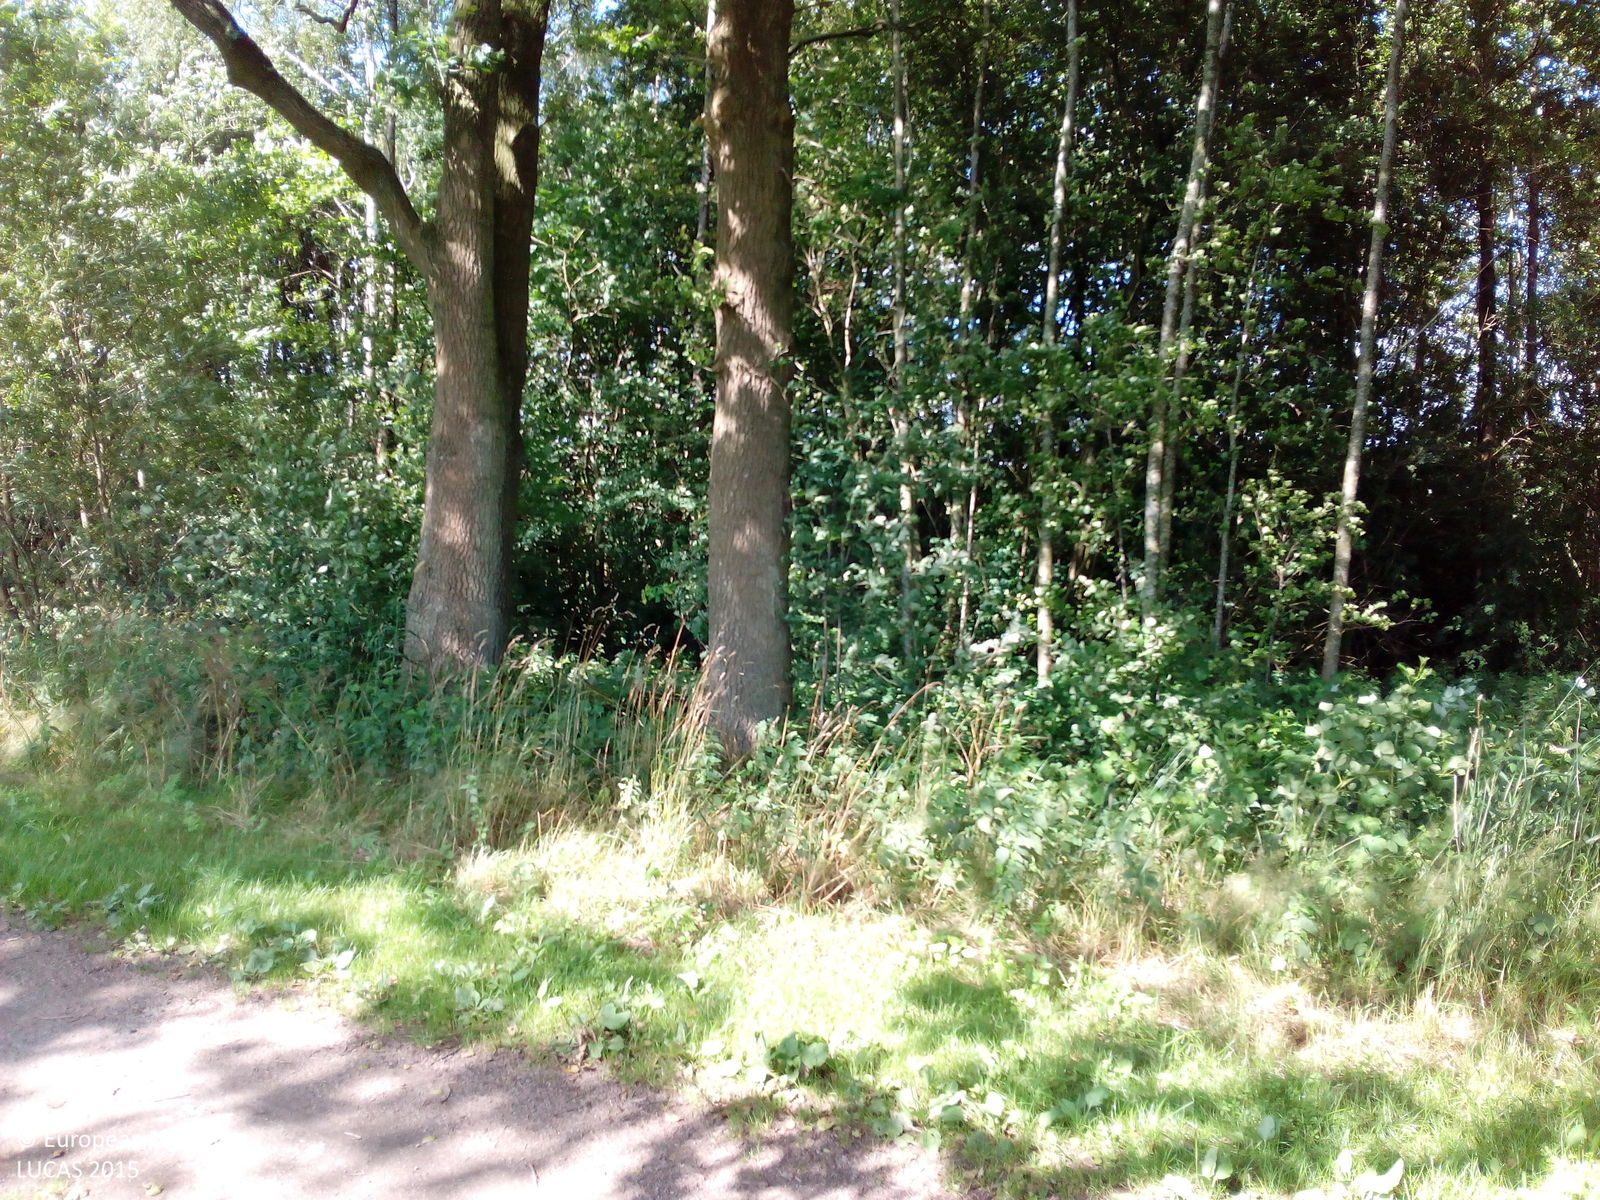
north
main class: Artificial land
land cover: Other artificial areas
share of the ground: > 75 %
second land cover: Grassland without tree/shrub cover
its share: > 75 %
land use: Energy production
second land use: Agriculture (excluding fallow land and kitchen gardens)
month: July
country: DE
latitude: 53.1155
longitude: 7.9836
